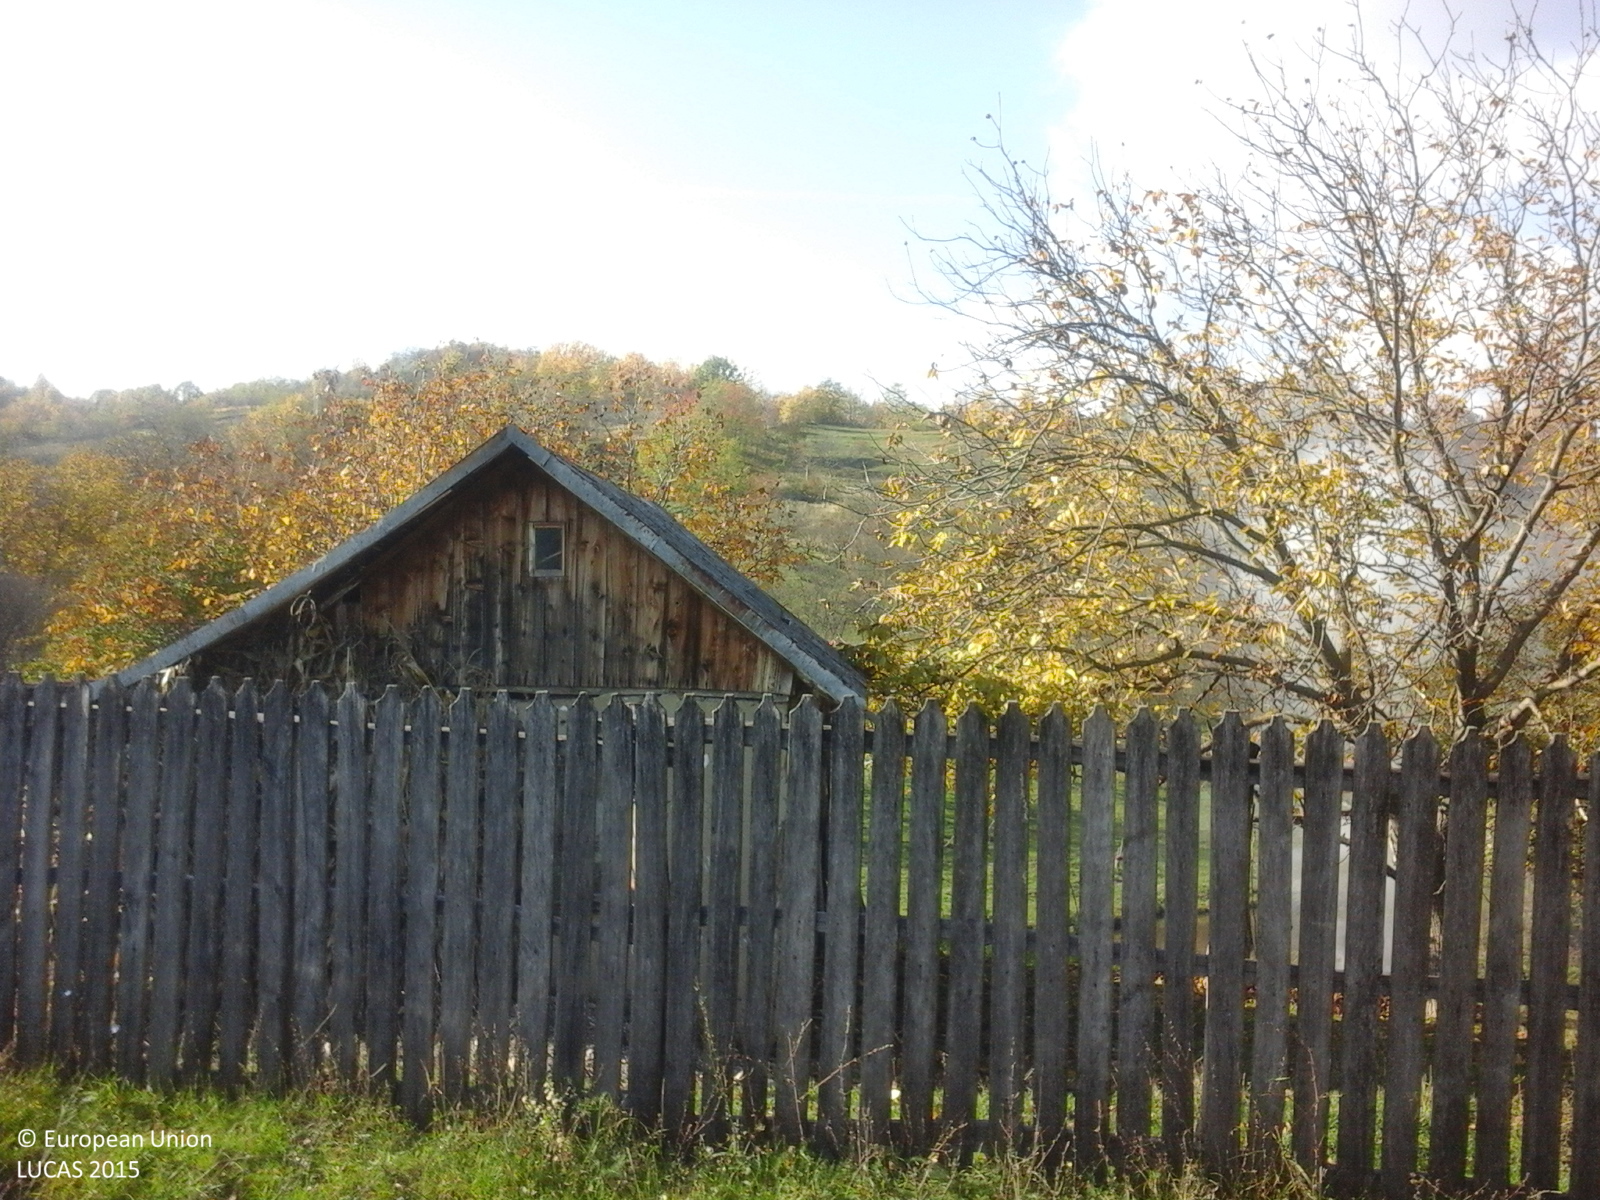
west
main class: Grassland
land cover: Grassland with sparse tree/shrub cover
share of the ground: > 75 %
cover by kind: herbaceous plants 95 %, broadleaved forest trees 5 %
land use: Agriculture (excluding fallow land and kitchen gardens)
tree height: > 5 m
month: October
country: RO
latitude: 45.5976
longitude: 26.9189
